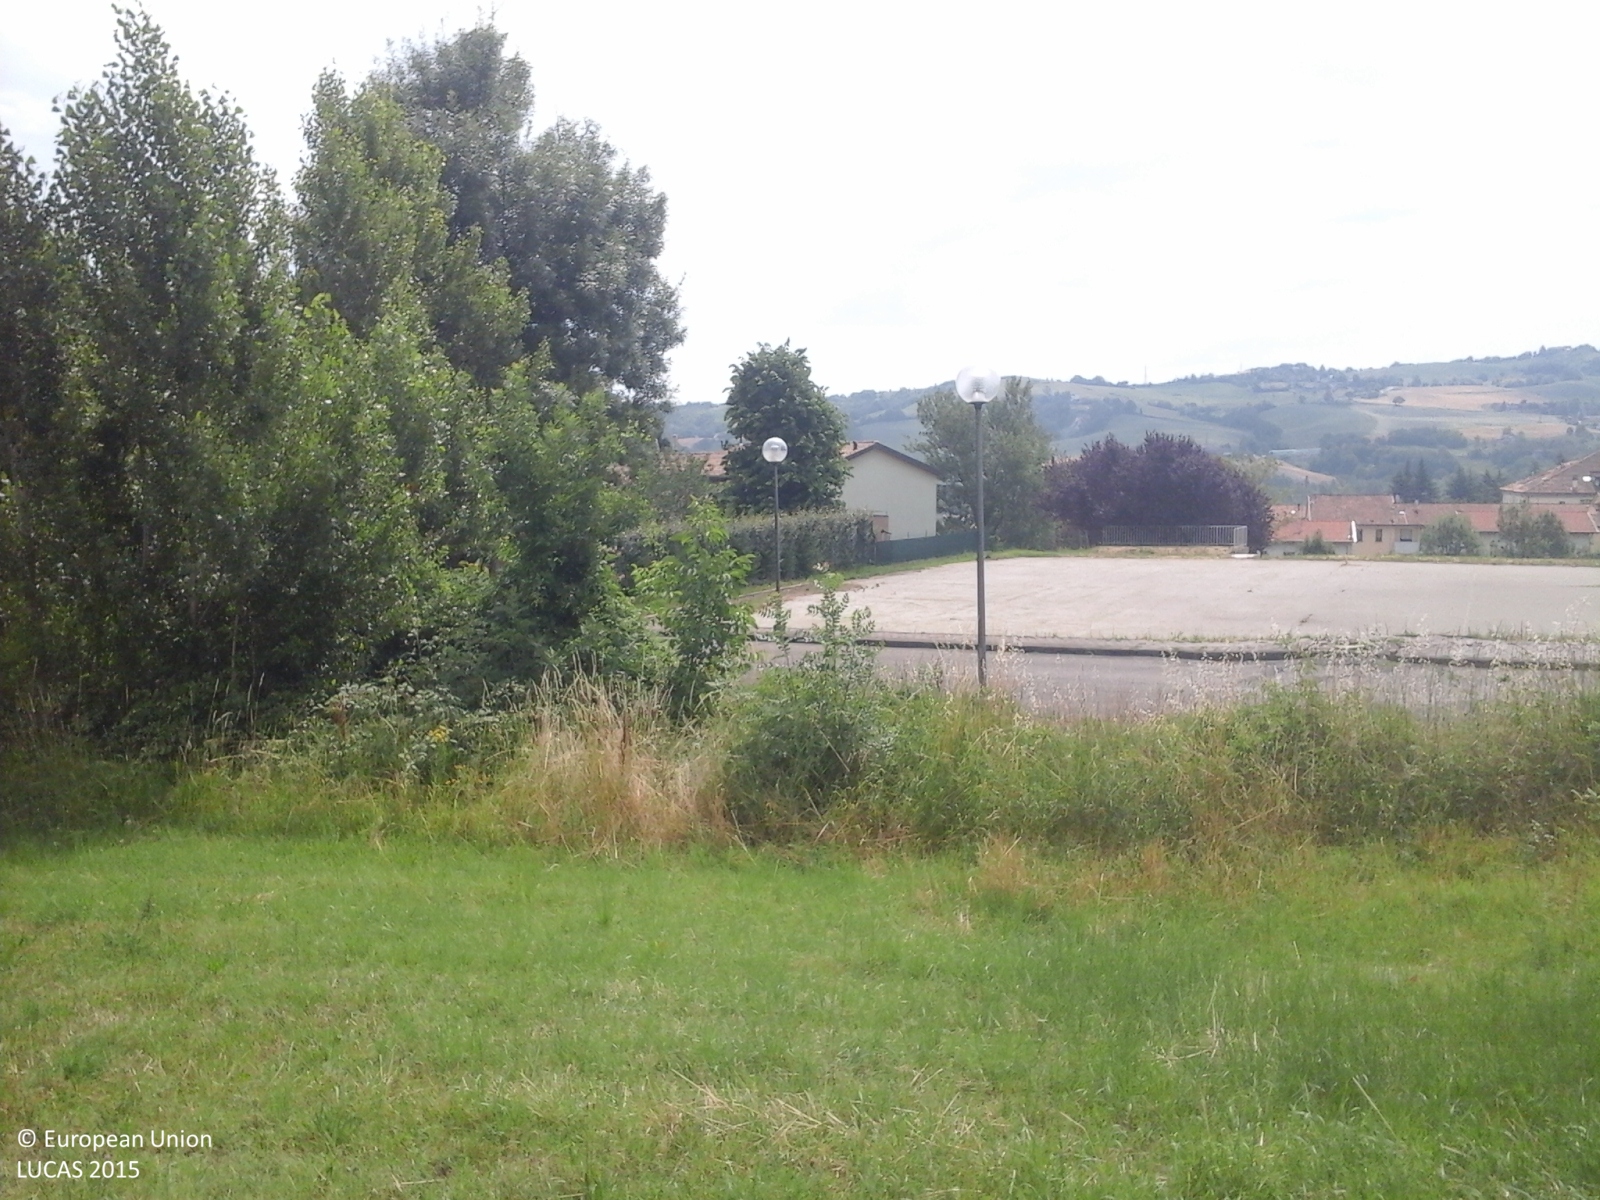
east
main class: Grassland
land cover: Grassland without tree/shrub cover
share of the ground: > 75 %
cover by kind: herbaceous plants 100 %
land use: Agriculture (excluding fallow land and kitchen gardens)
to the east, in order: Grassland without tree/shrub cover; Artificial constructions in urban areas
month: June
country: IT
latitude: 44.6207
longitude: 10.2641
